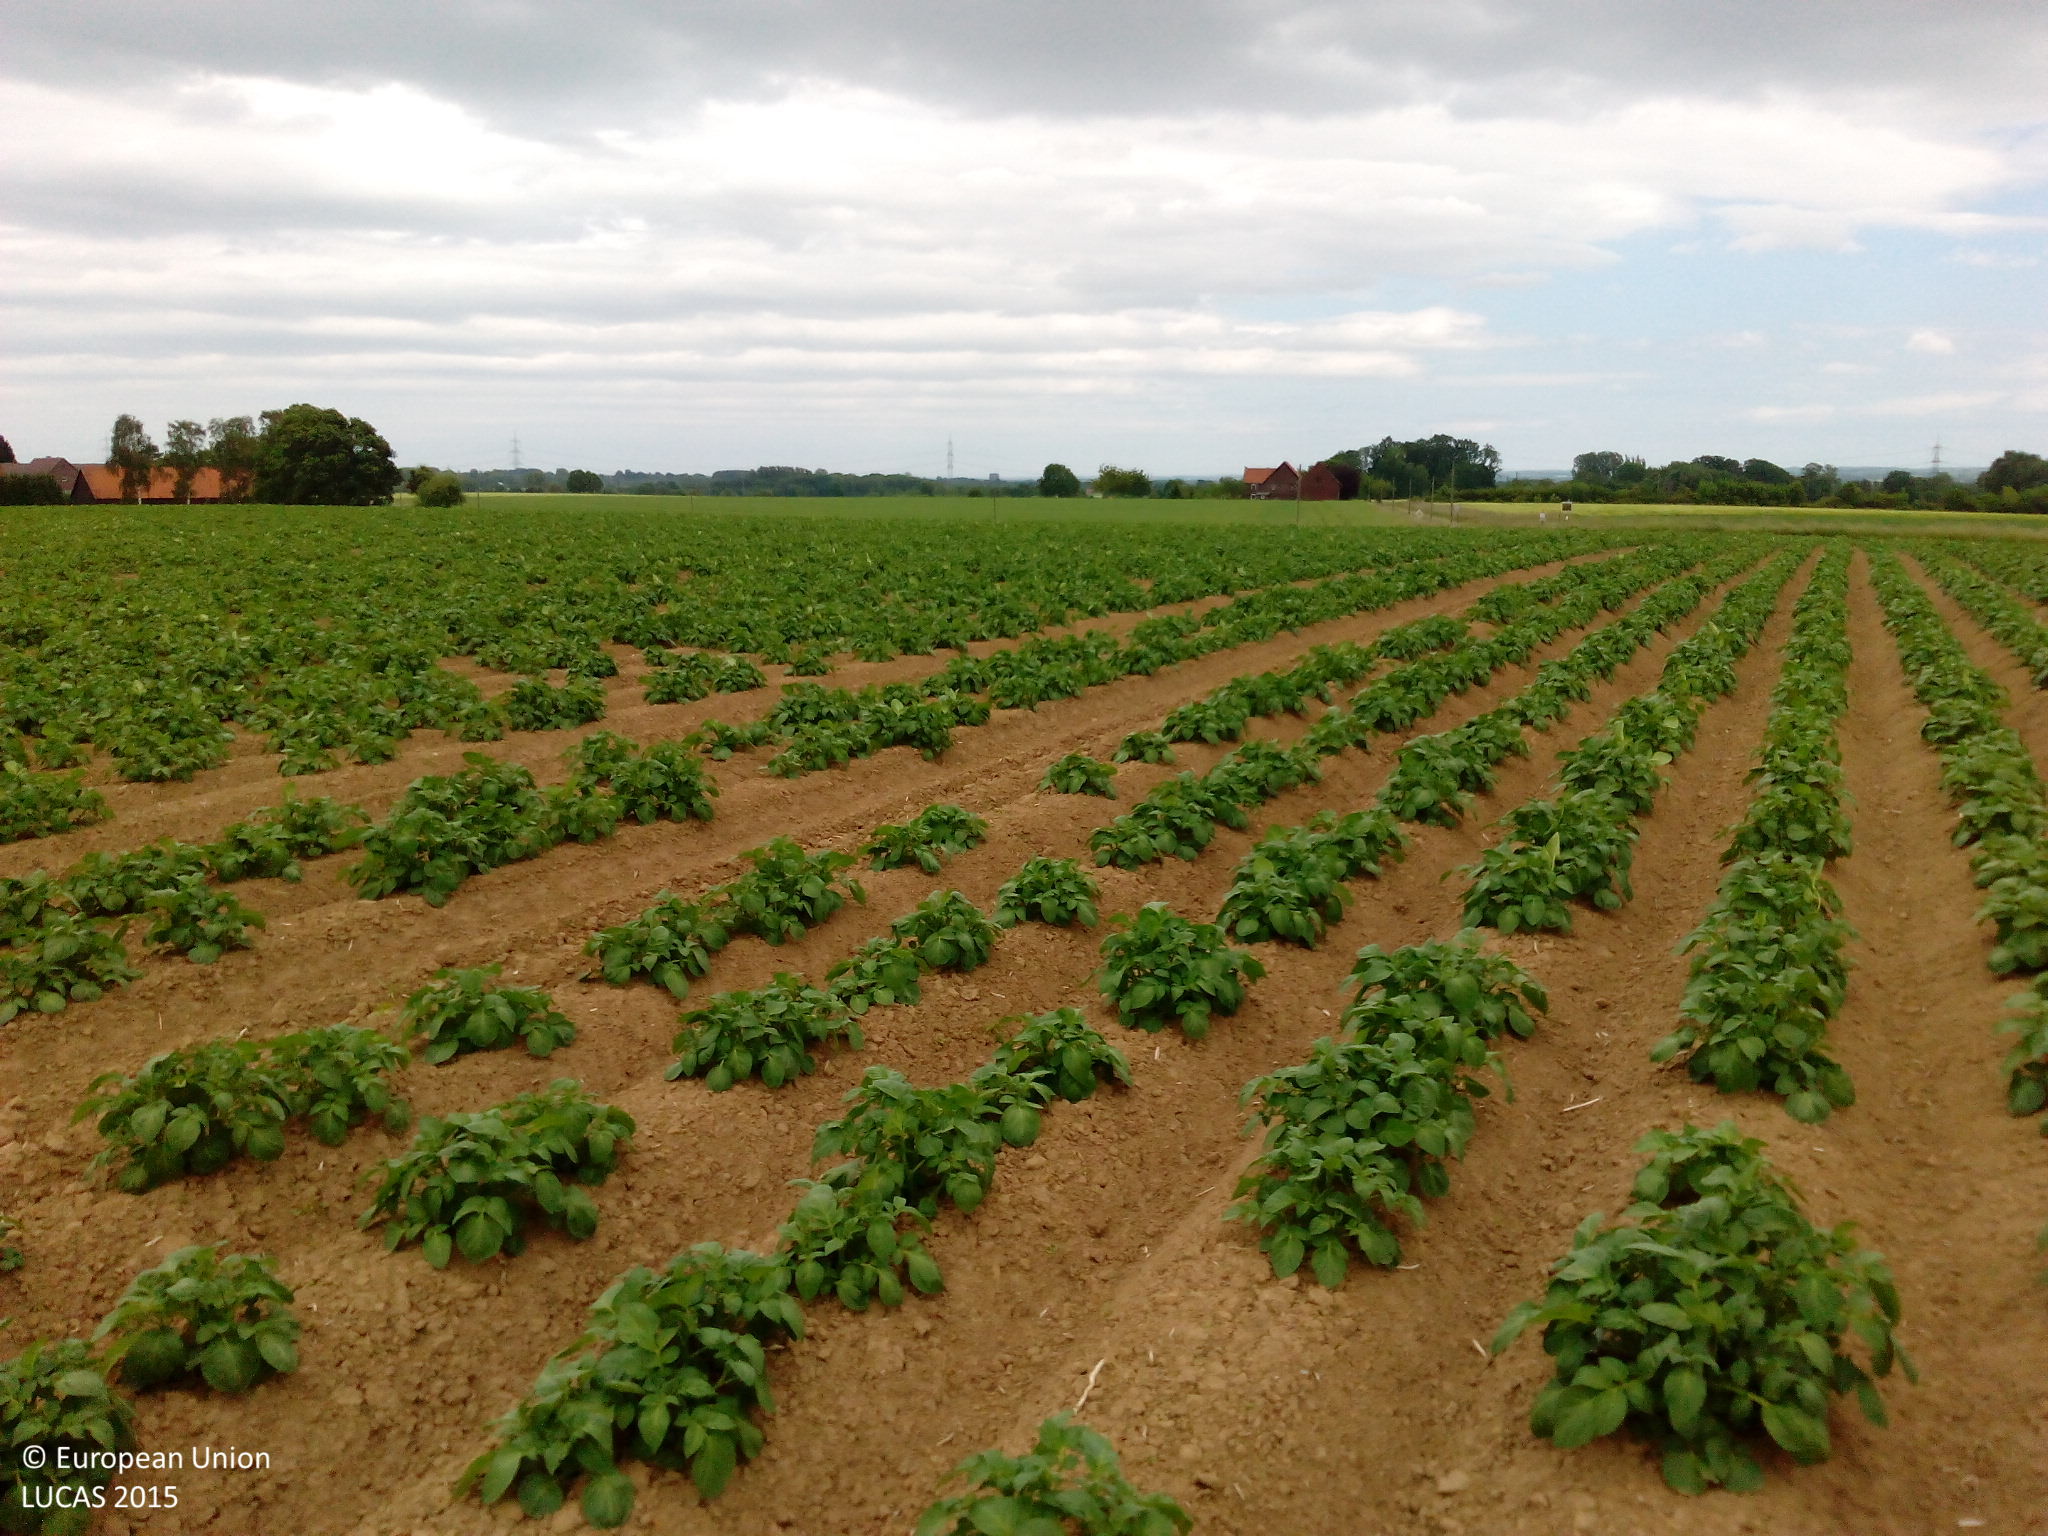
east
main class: Cropland
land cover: Potatoes
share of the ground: 10 - 25 %
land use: Agriculture (excluding fallow land and kitchen gardens)
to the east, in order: Potatoes; Grass margins; Ditches and canals; Paved roads, cycling and walking lanes; Grass margins; Electric lines; Ditches and canals; Grassland without tree/shrub cover; Rape and turnip rape
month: June
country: DE
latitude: 51.5874
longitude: 7.9942
